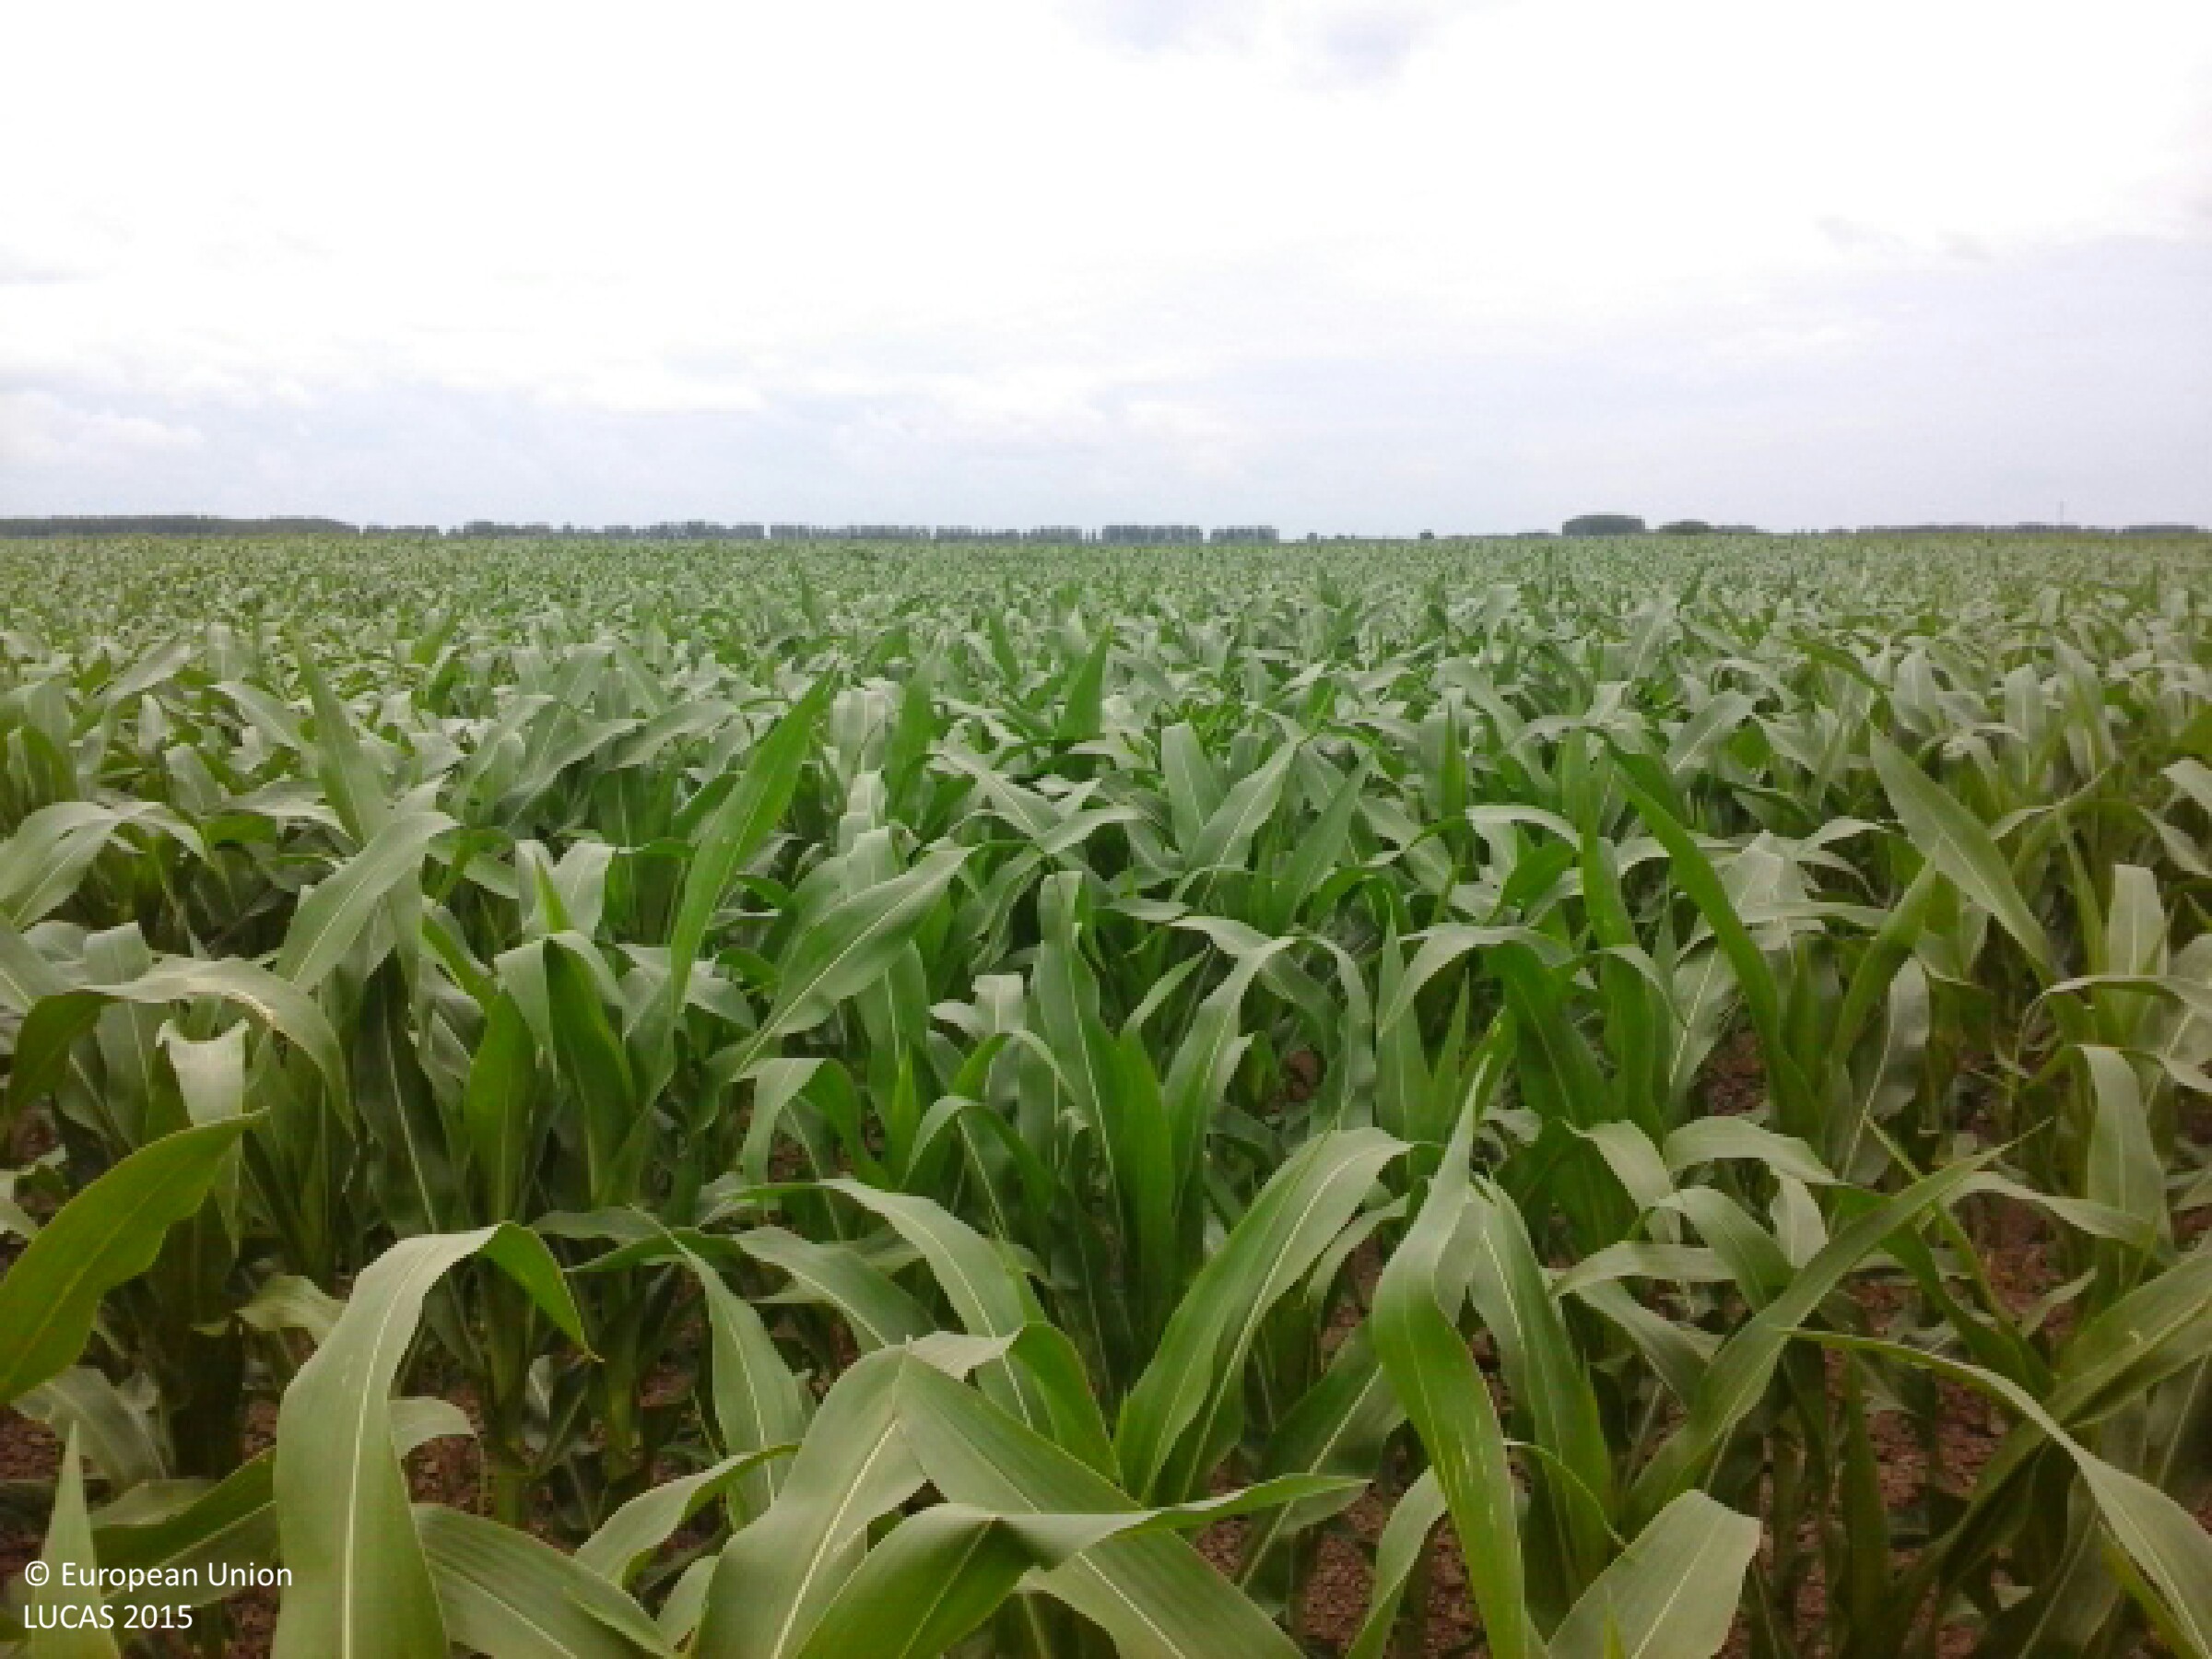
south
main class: Cropland
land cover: Maize
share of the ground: 50 - 75 %
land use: Agriculture (excluding fallow land and kitchen gardens)
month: June
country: HU
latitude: 48.1583
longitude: 21.7315
